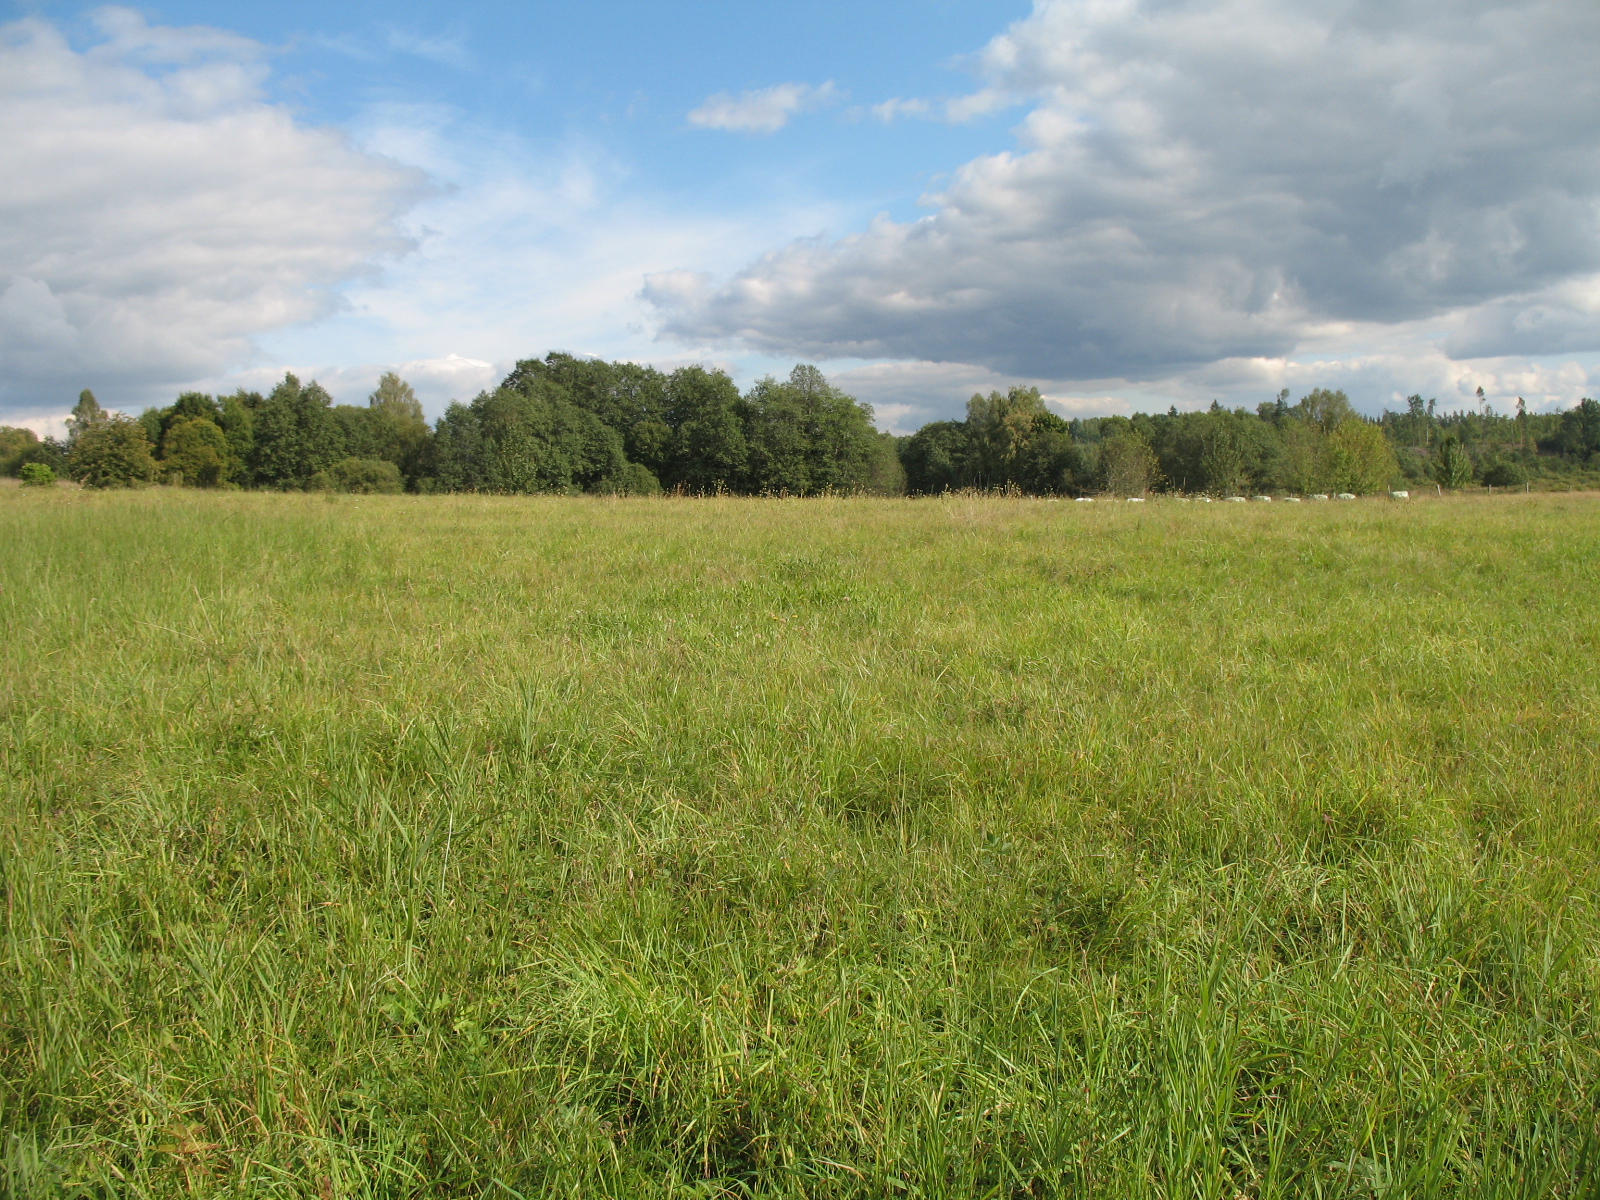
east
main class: Grassland
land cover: Grassland without tree/shrub cover
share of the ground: > 75 %
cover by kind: herbaceous plants 100 %
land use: Agriculture (excluding fallow land and kitchen gardens)
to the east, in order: Grassland without tree/shrub cover; Single bushes/trees; Paved roads, cycling and walking lanes; Fences; Grassland without tree/shrub cover; Broadleaved woodland
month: September
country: LV
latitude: 56.1554
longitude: 25.4966
